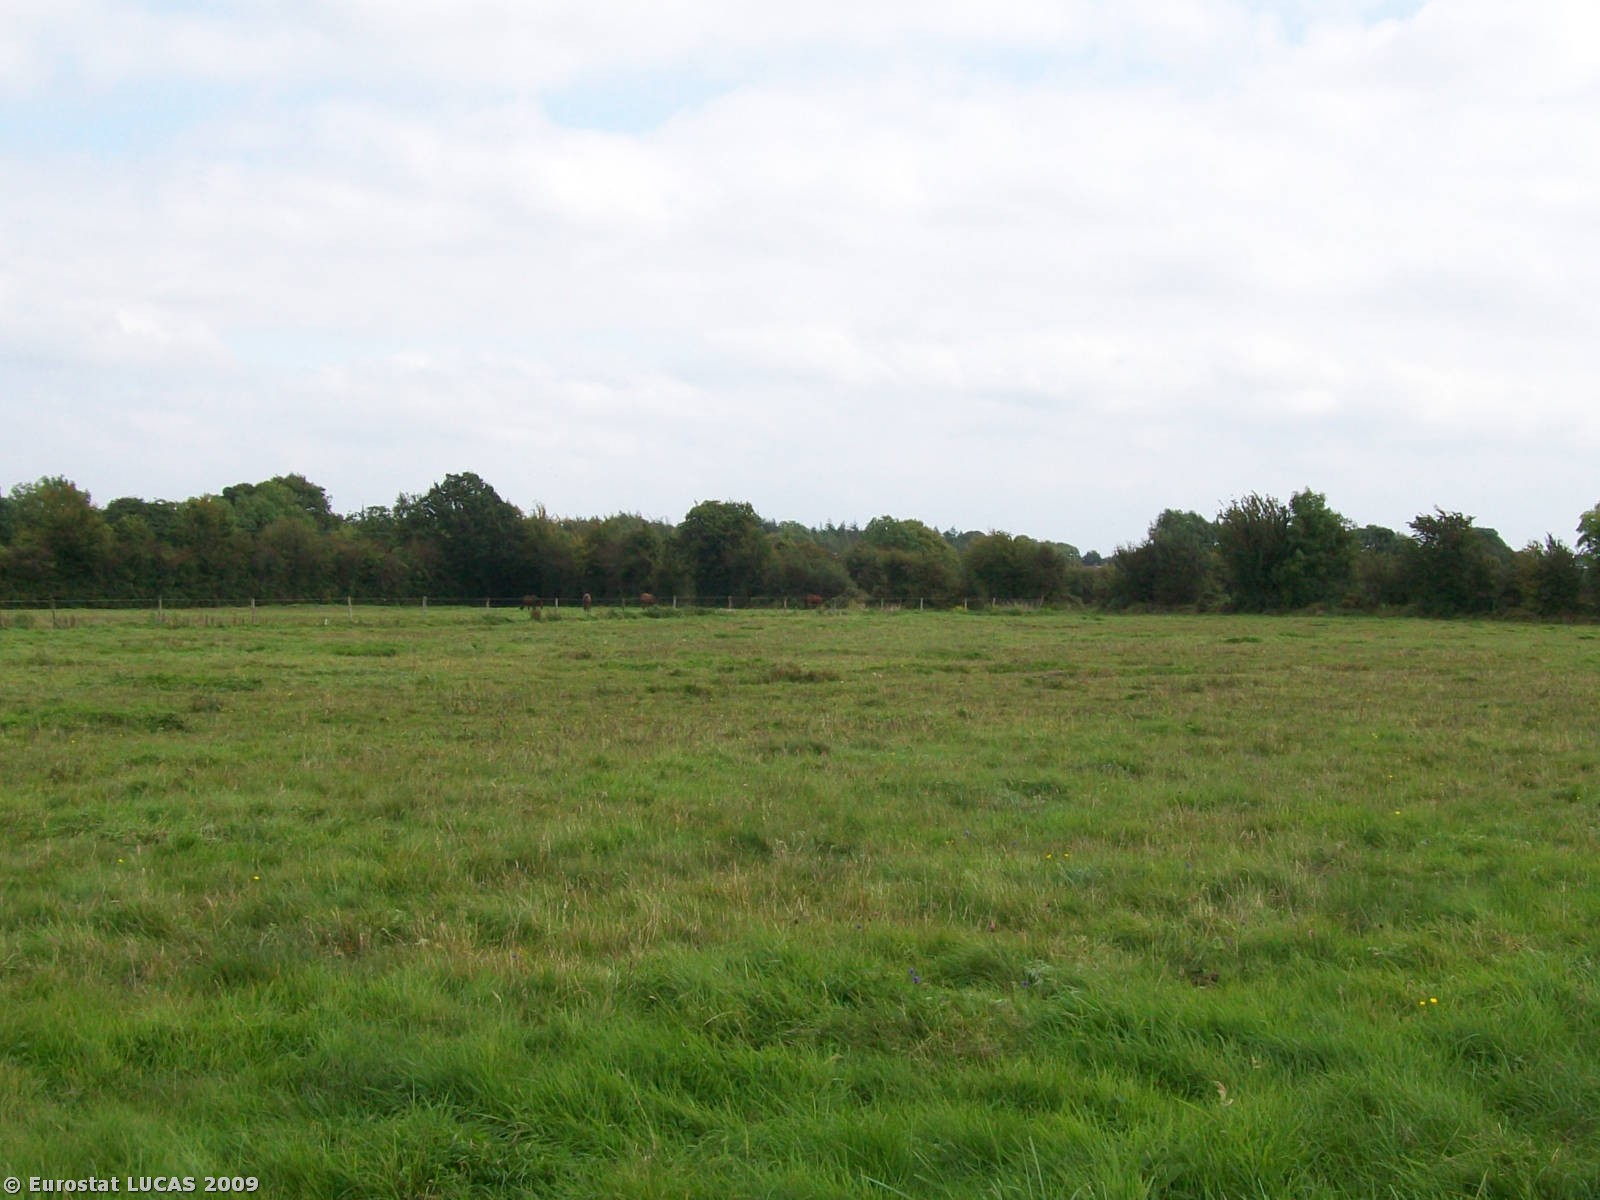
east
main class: Grassland
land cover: Grassland without tree/shrub cover
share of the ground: > 75 %
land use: Agriculture (excluding fallow land and kitchen gardens)
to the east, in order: Grassland without tree/shrub cover; Managed hedges; Ditches and canals; Fences; Grassland without tree/shrub cover
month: September
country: IE
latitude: 52.9599
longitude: -7.8717
